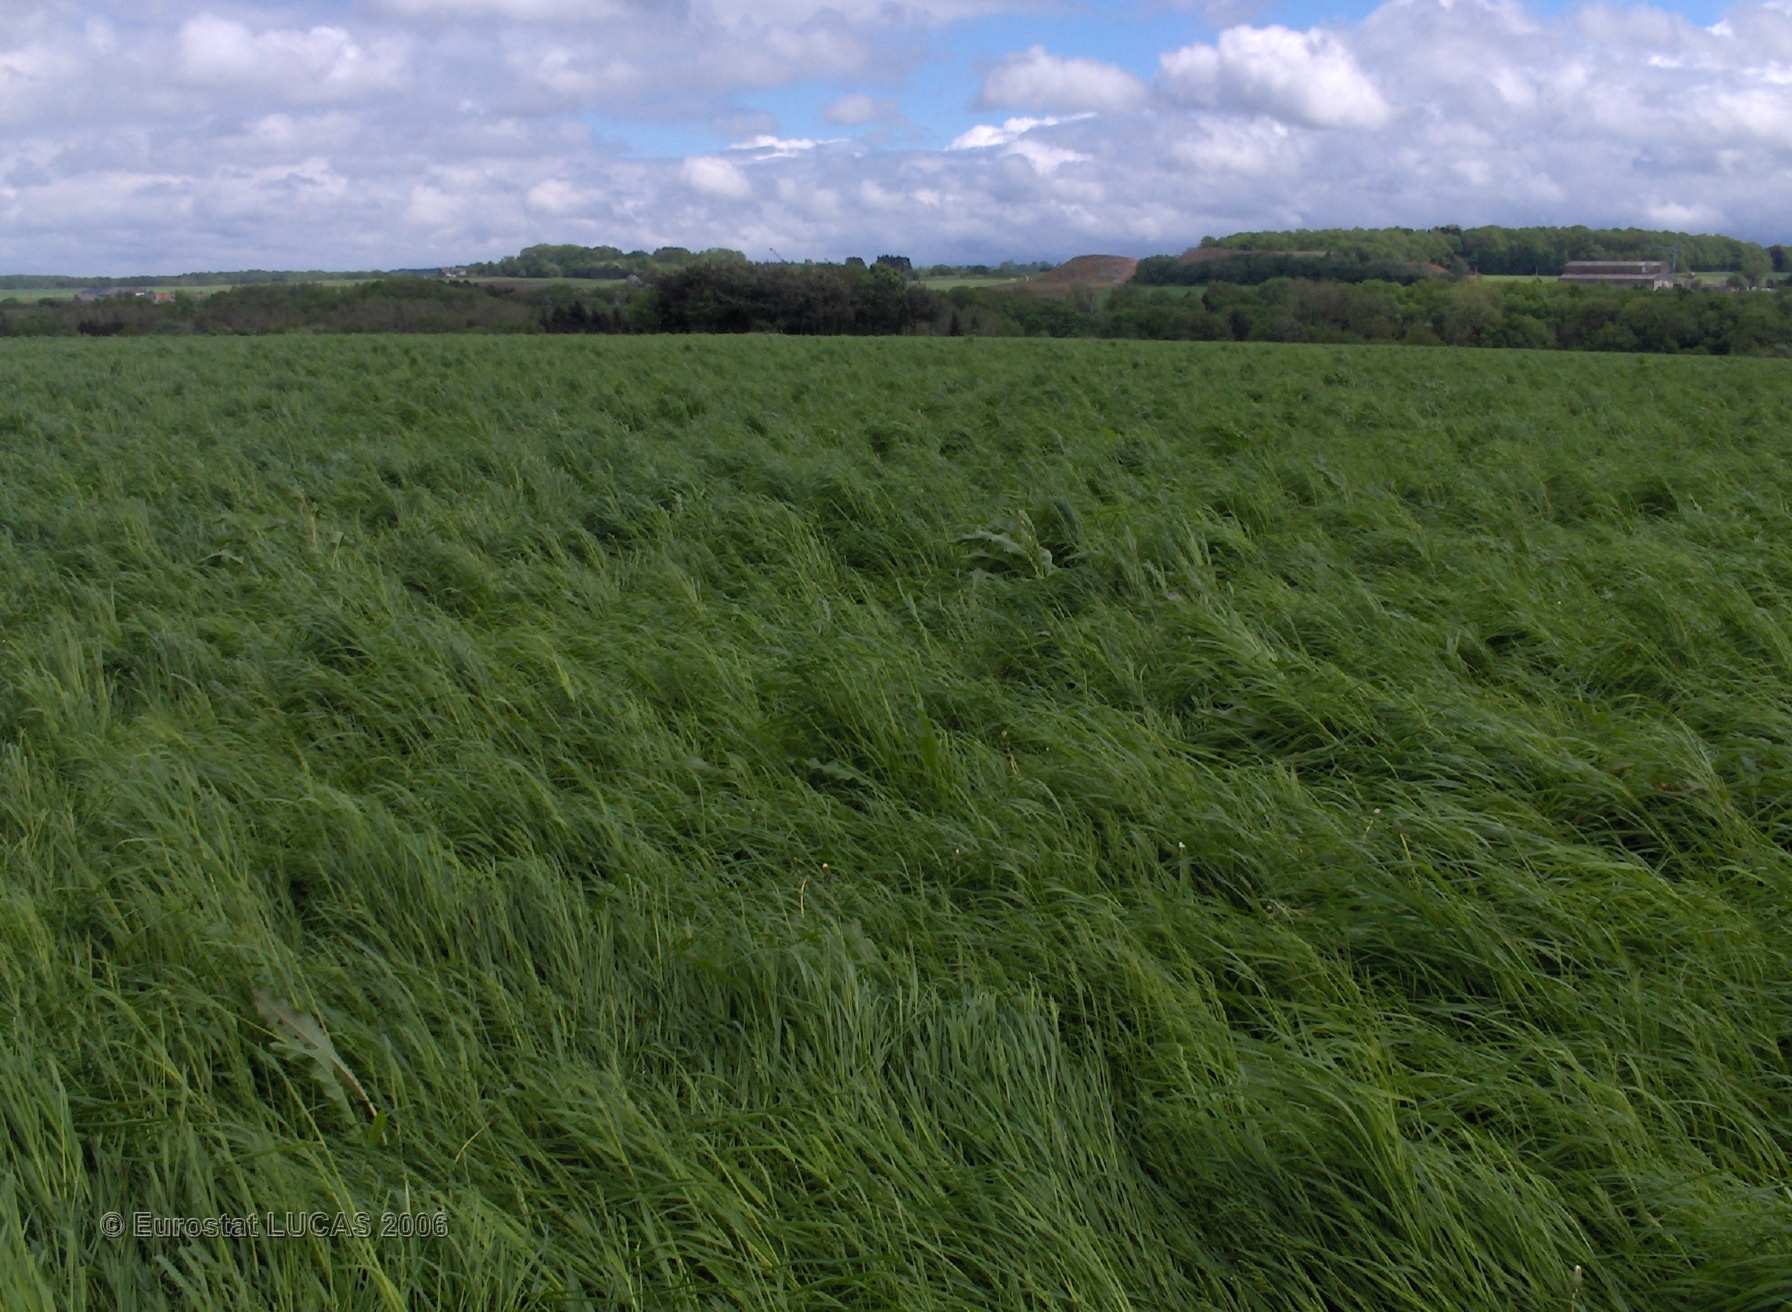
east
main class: Grassland
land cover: Grassland without tree/shrub cover
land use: Agriculture (excluding fallow land and kitchen gardens)
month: May
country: BE
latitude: 50.4109
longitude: 5.2837
